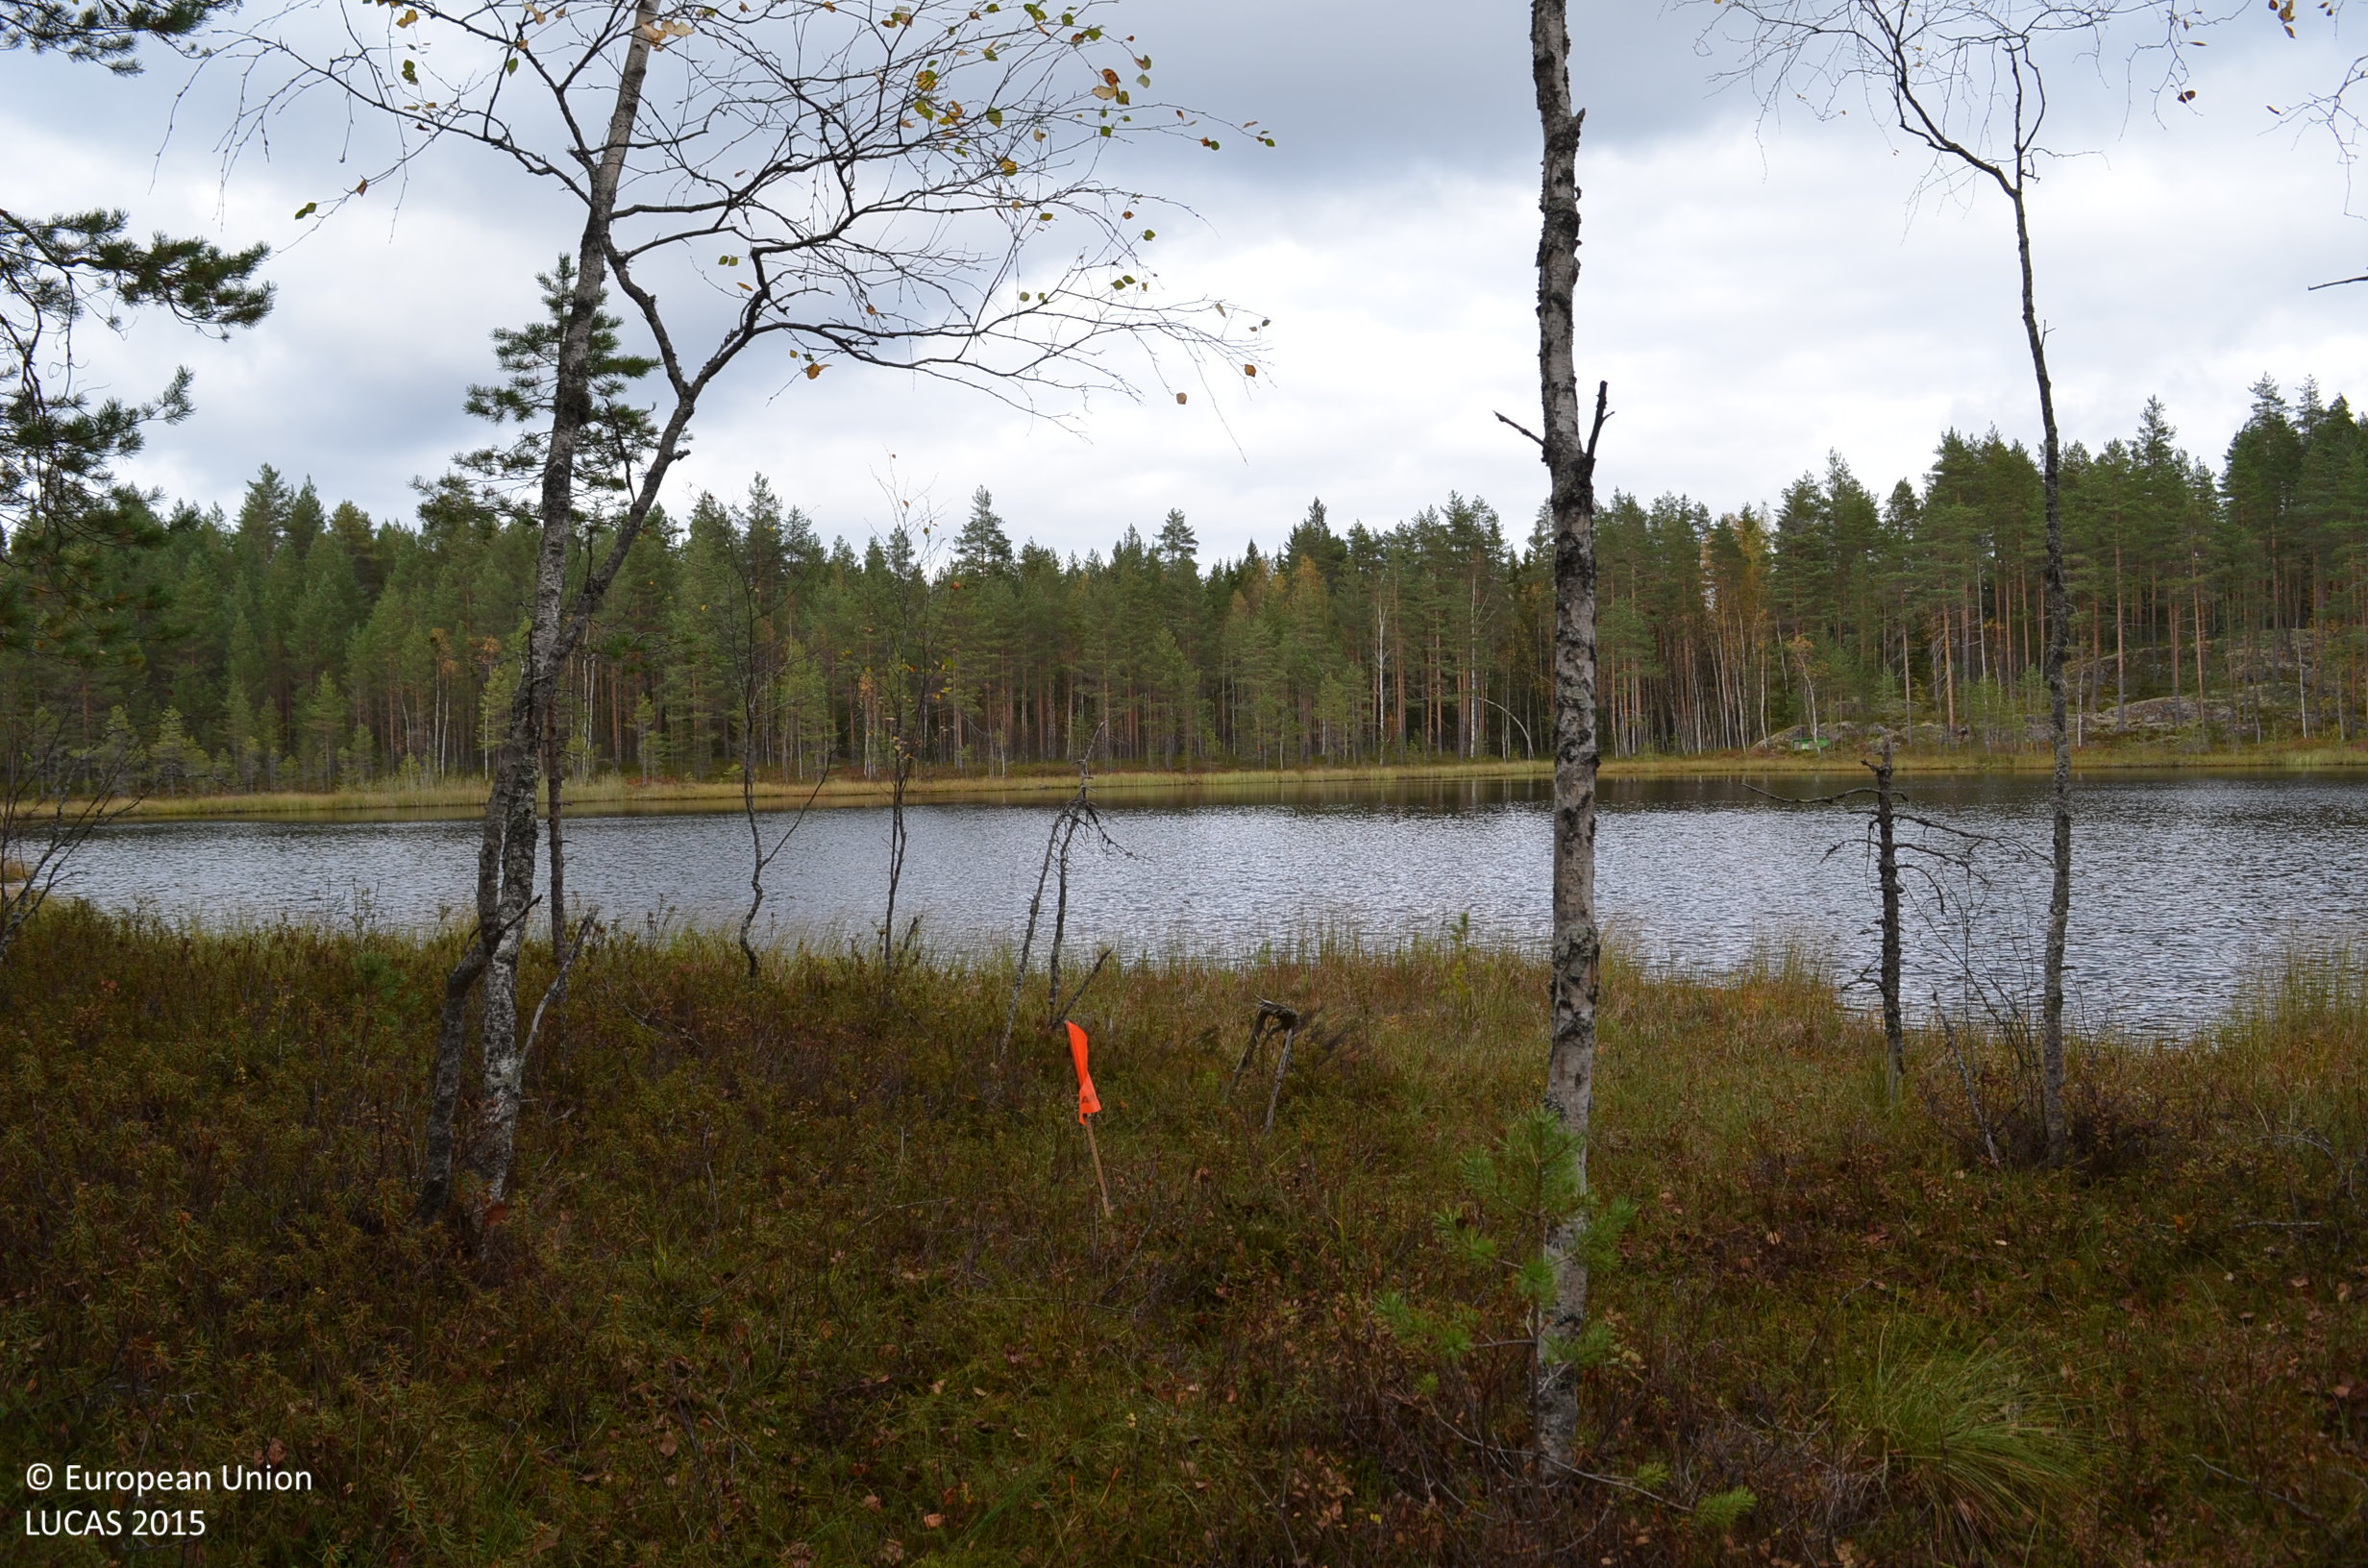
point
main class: Woodland
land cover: Pine dominated mixed woodland
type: boreal forest
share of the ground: 50 - 75 %
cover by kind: coniferous forest trees 50 %, shrubs 25 %, broadleaved forest trees 20 %, lichens and mosses 5 %
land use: Forestry
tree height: > 5 m
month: September
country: FI
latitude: 62.4308
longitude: 23.6116
